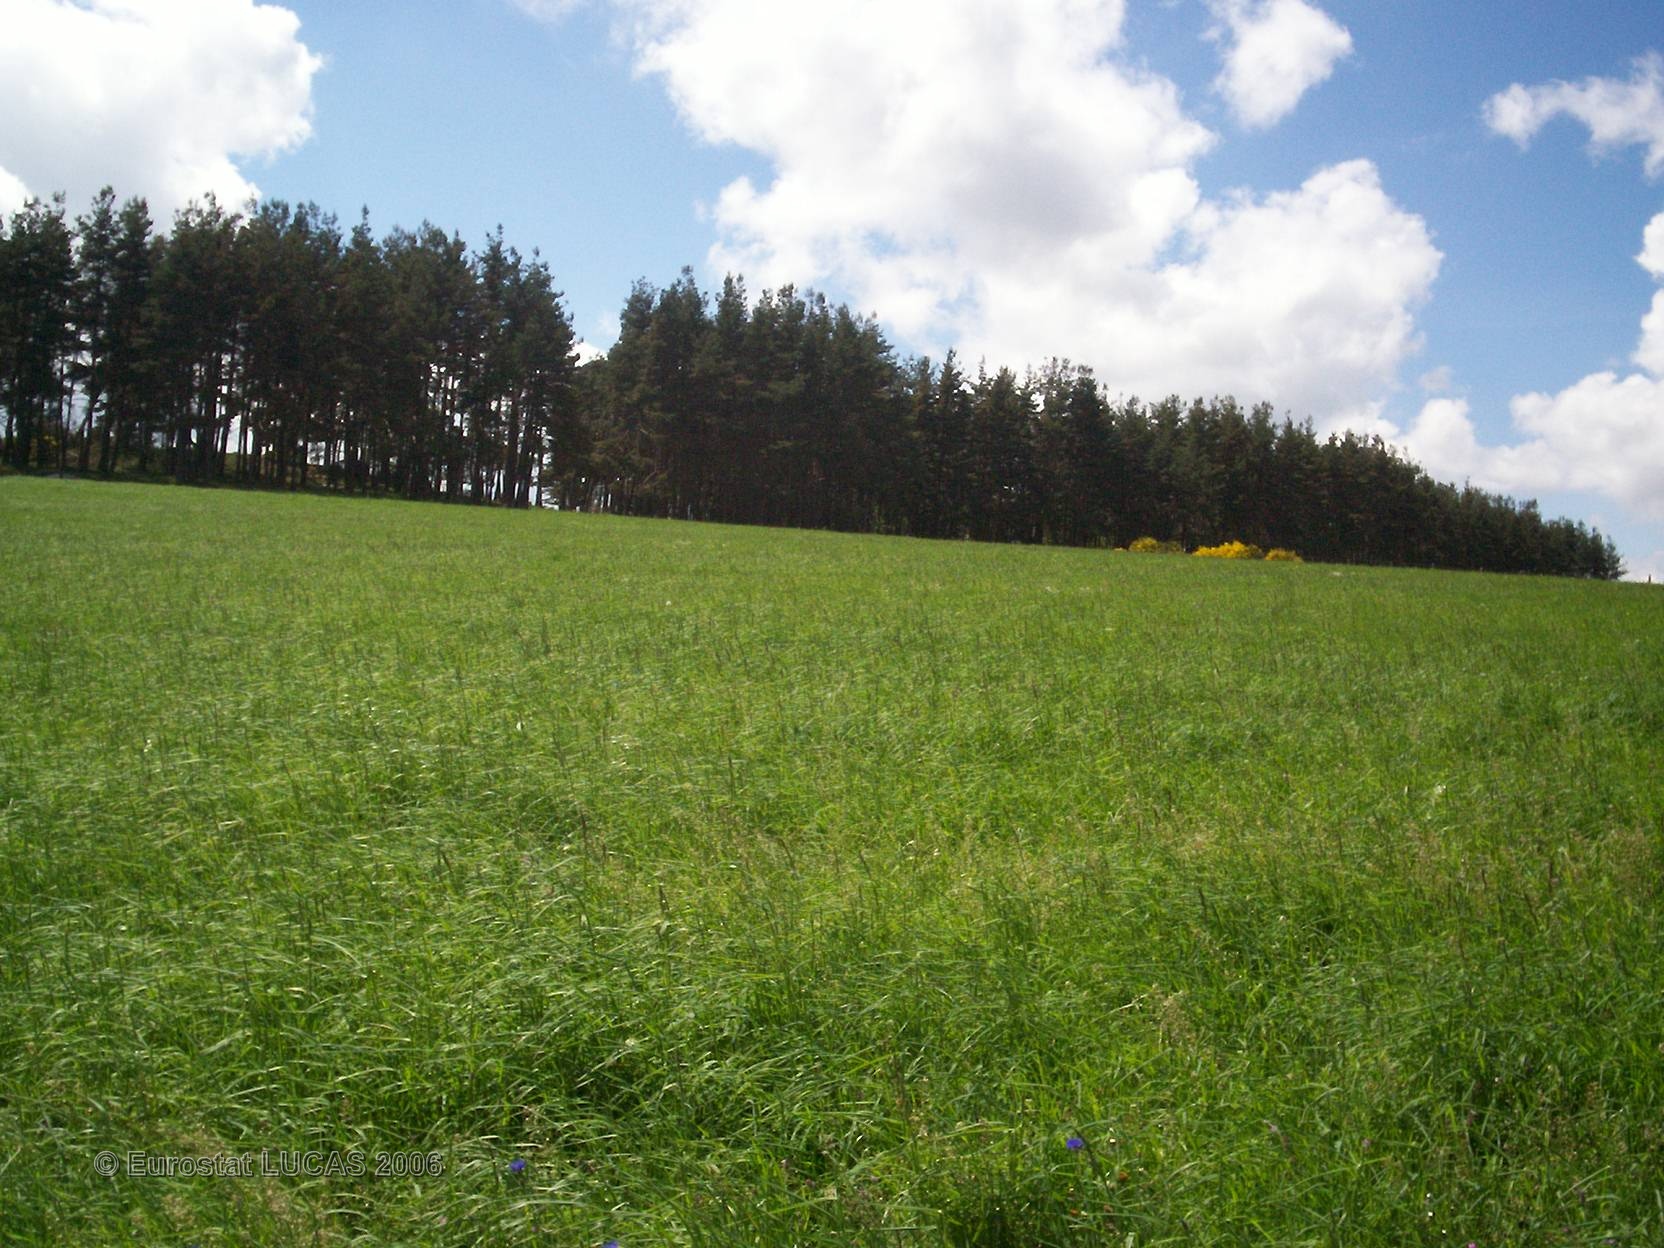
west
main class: Grassland
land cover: Grassland without tree/shrub cover
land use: Agriculture (excluding fallow land and kitchen gardens)
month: May
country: FR
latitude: 44.7879
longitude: 3.3429
